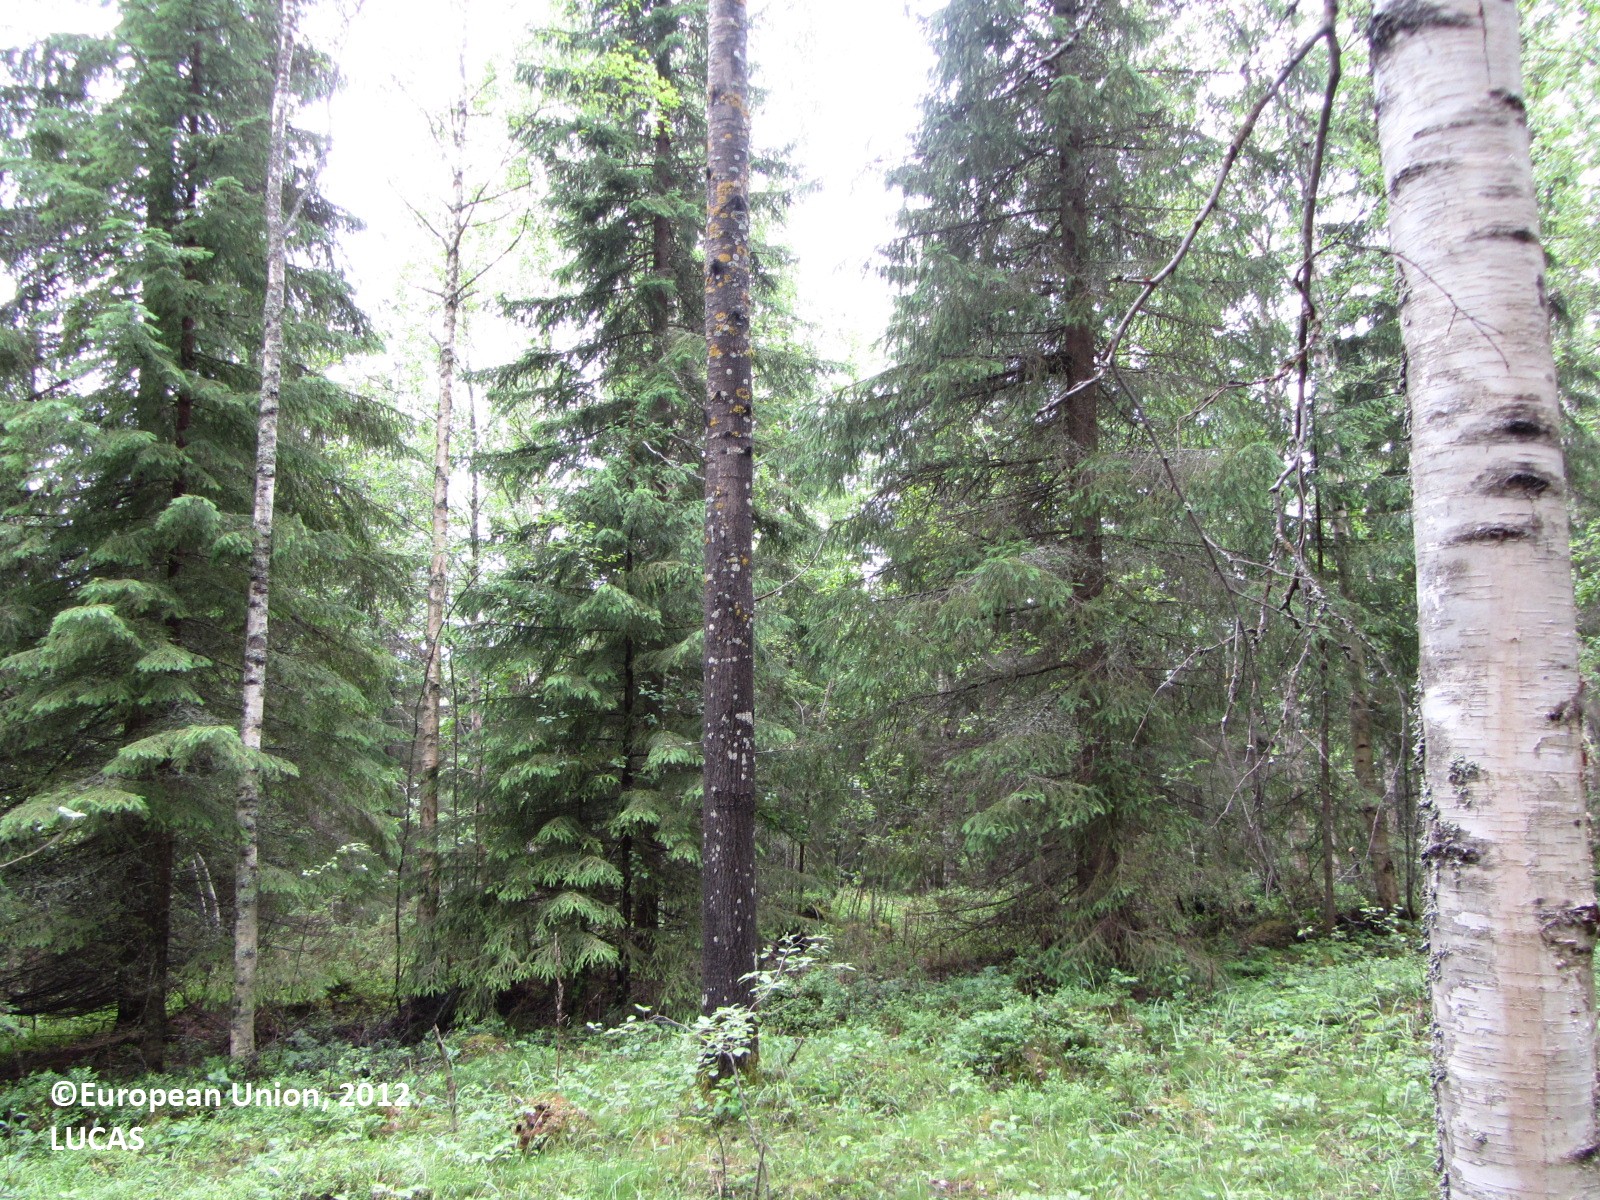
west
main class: Woodland
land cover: Spruce dominated mixed woodland
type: boreal forest
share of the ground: 50 - 75 %
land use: Forestry
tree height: > 5 m
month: July
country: FI
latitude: 62.9367
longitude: 25.0502
